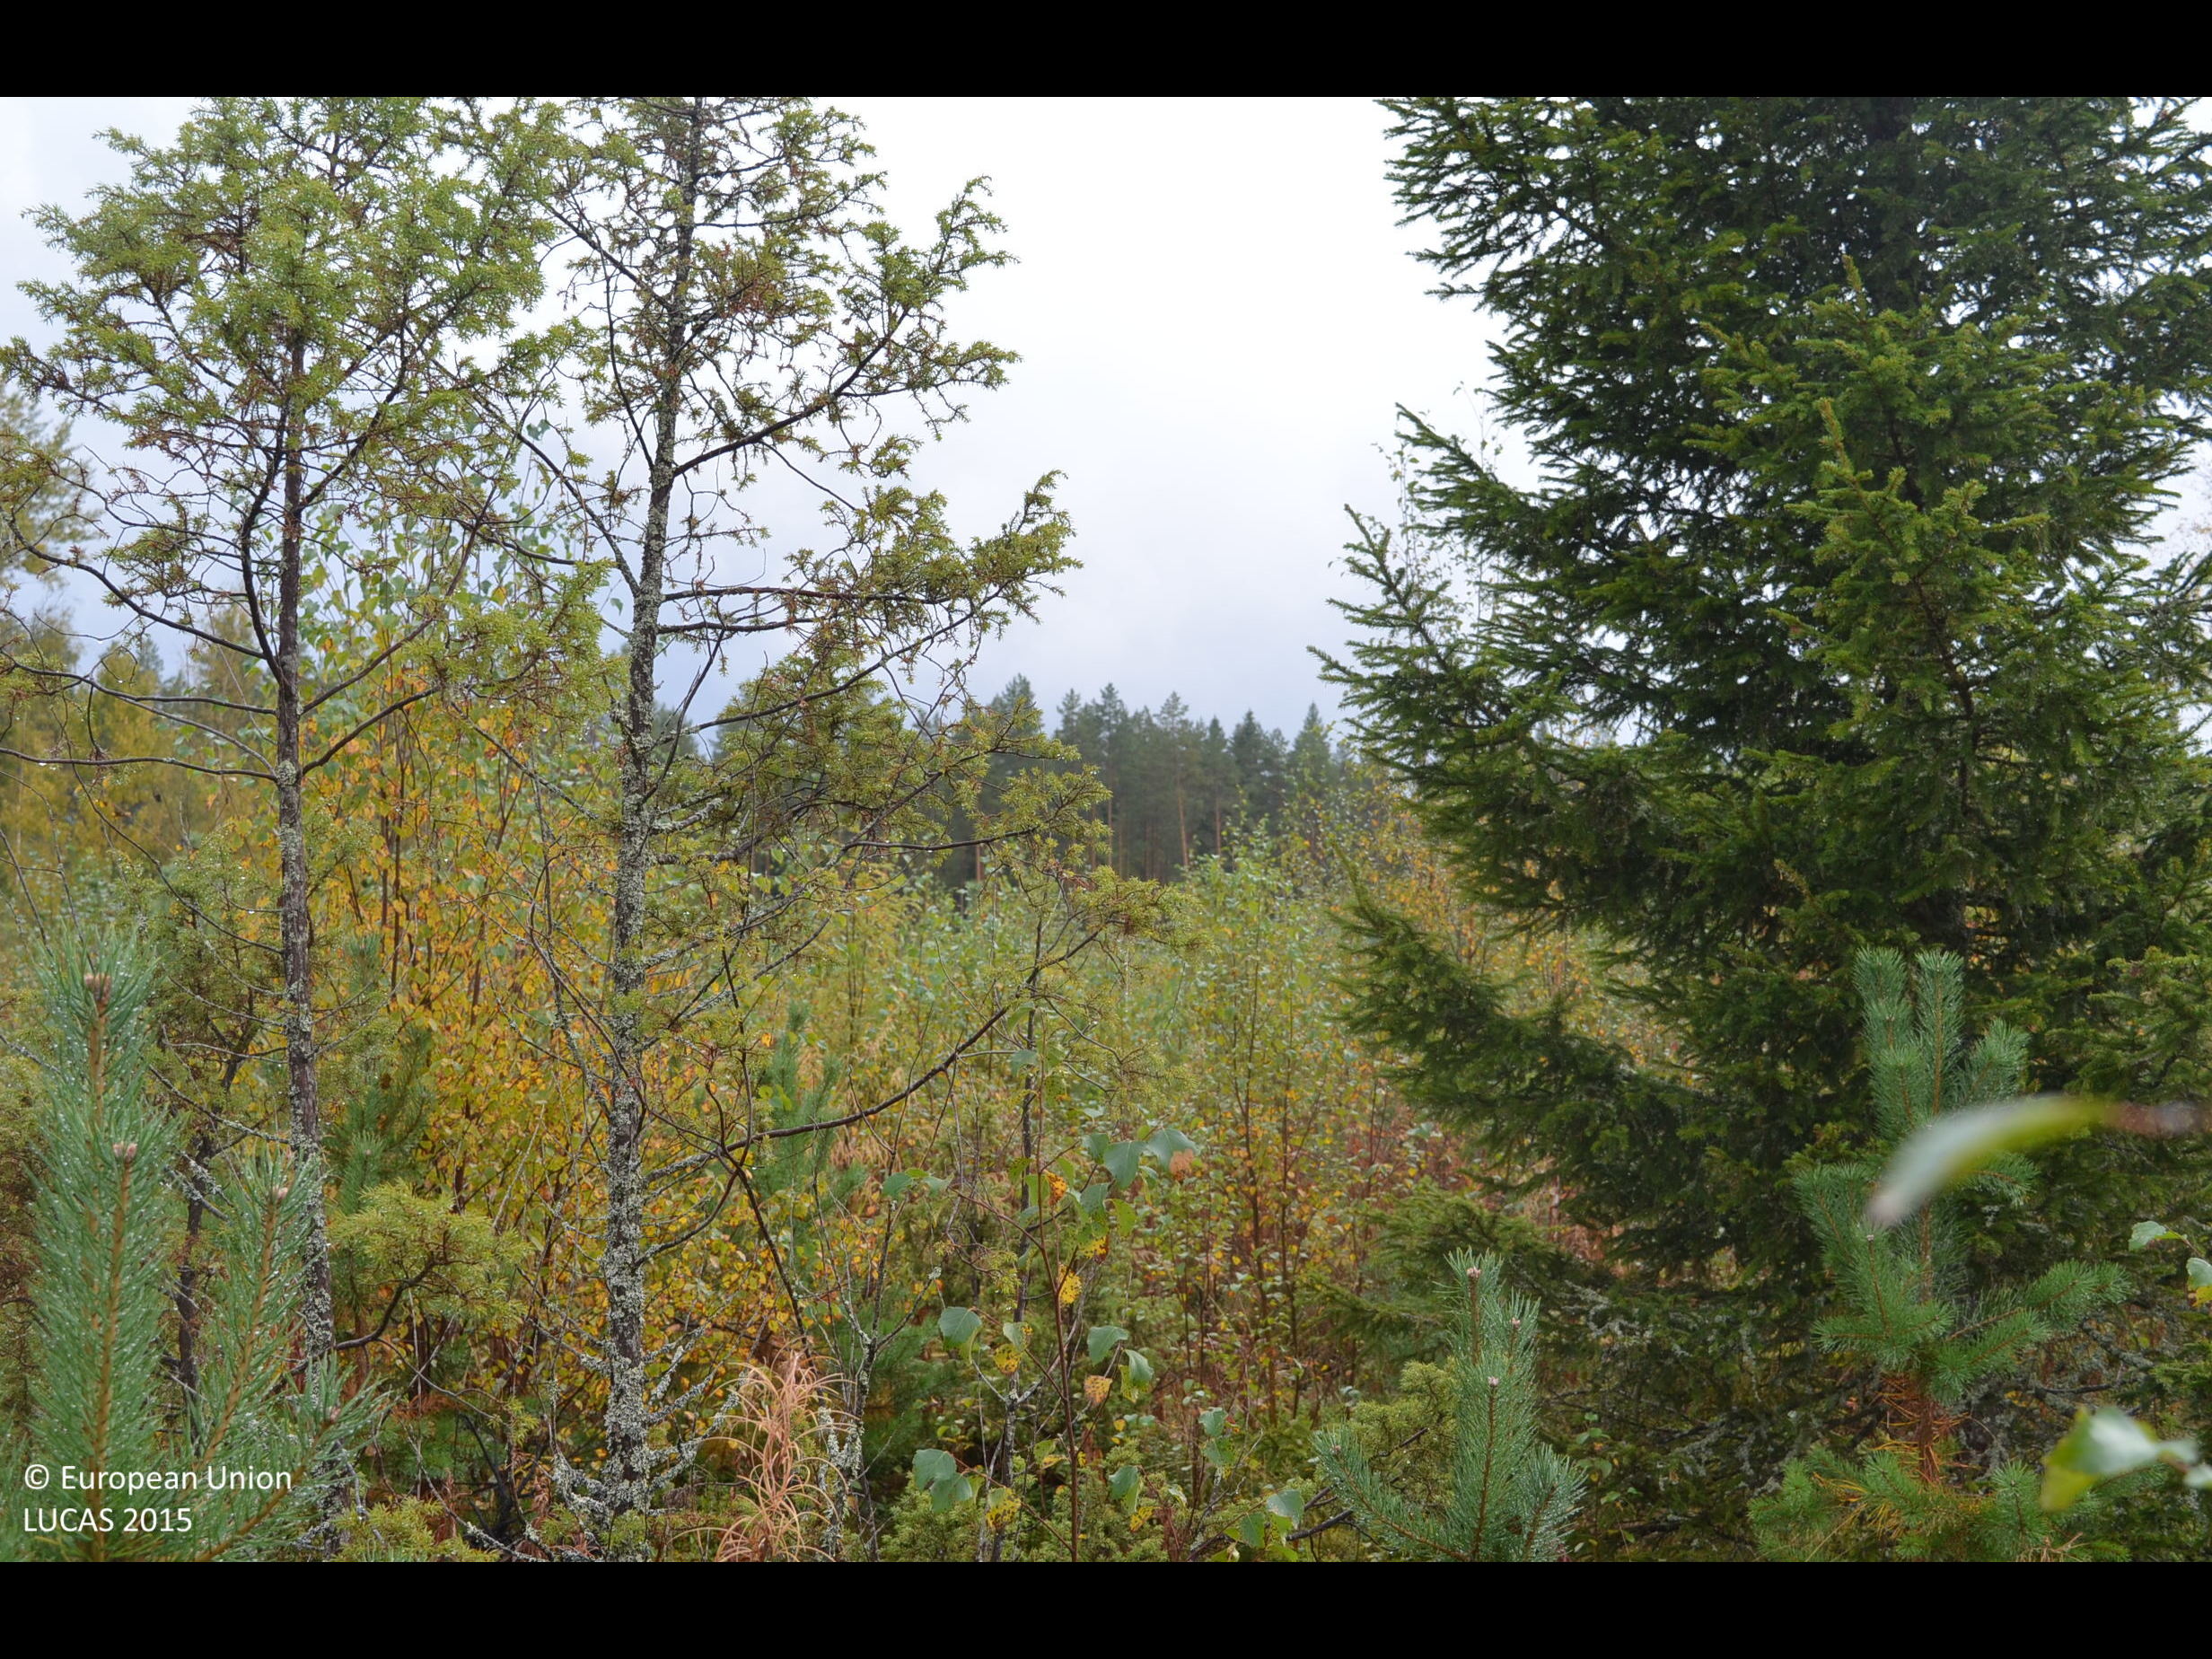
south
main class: Woodland
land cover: Pine dominated mixed woodland
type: boreal forest
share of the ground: 50 - 75 %
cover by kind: broadleaved forest trees 40 %, coniferous forest trees 30 %, herbaceous plants 15 %, shrubs 10 %, lichens and mosses 5 %
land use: Forestry
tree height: < 5 m
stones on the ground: < 10 %
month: September
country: FI
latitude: 62.9735
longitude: 23.9016
